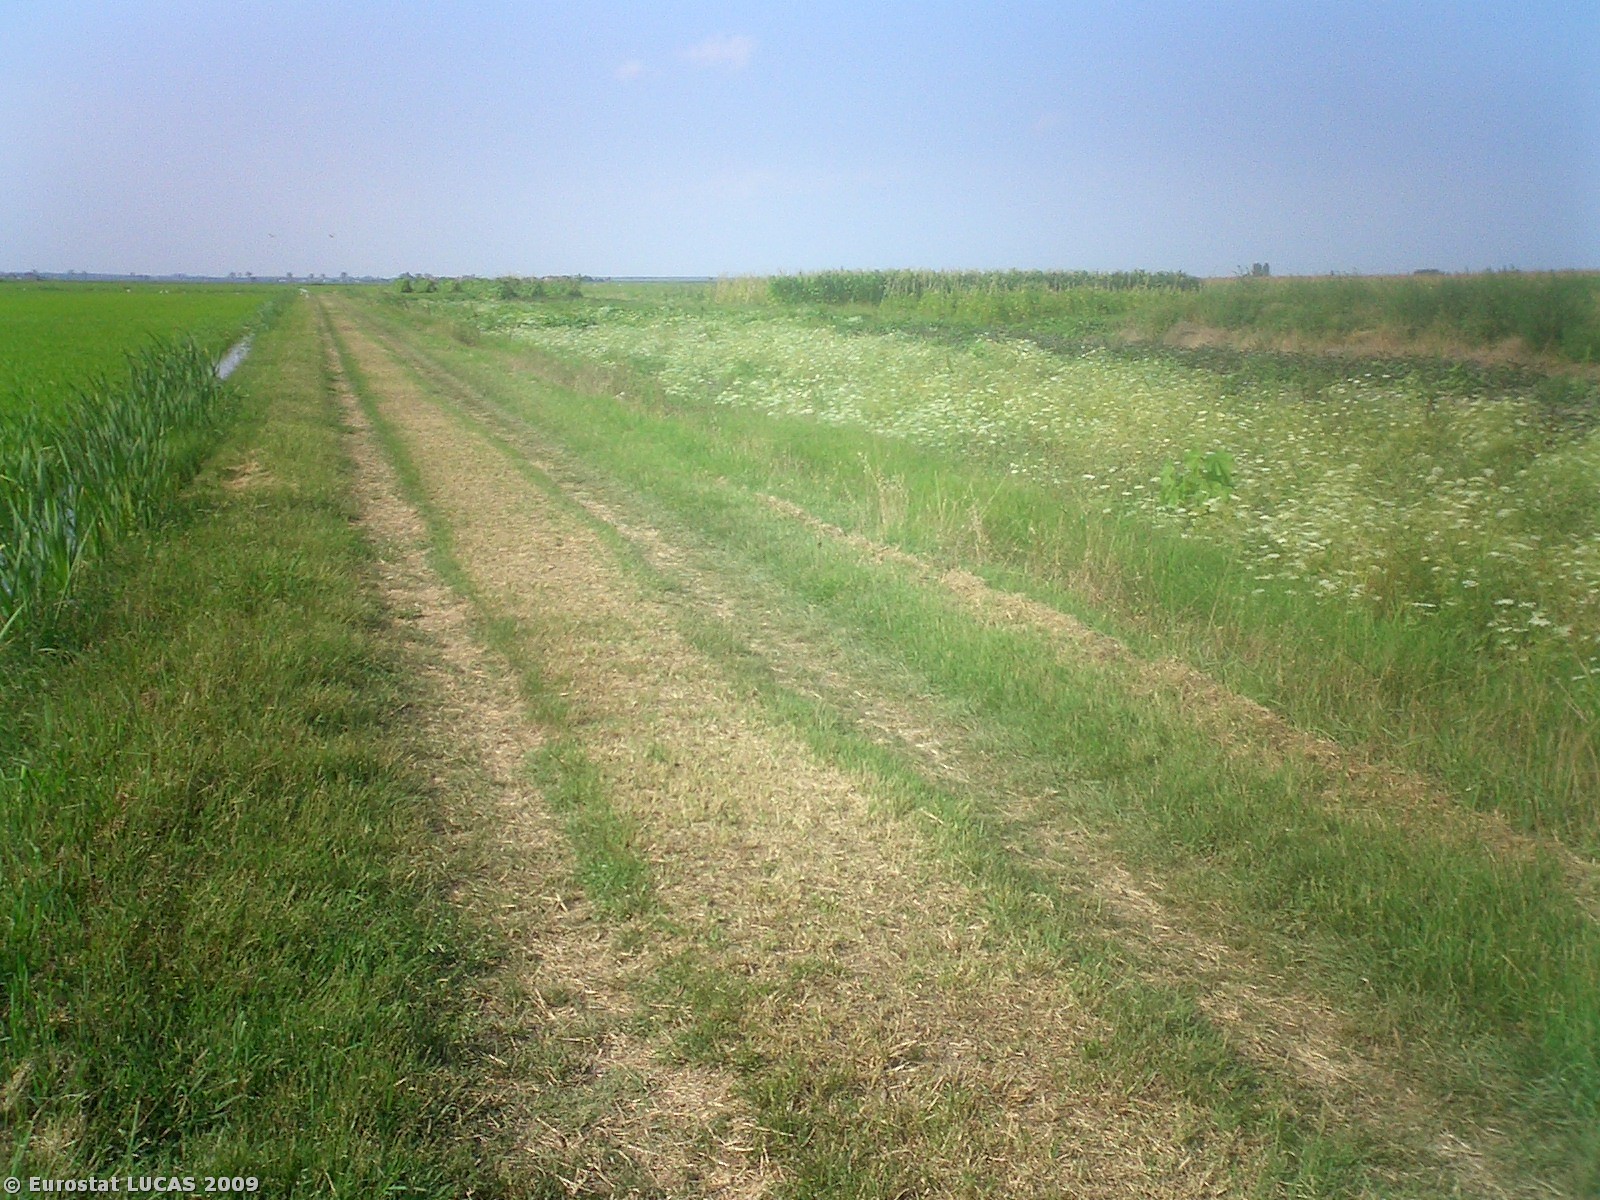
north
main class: Cropland
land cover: Rice
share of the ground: > 75 %
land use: Agriculture (excluding fallow land and kitchen gardens)
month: July
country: IT
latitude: 44.8888
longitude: 12.0852
